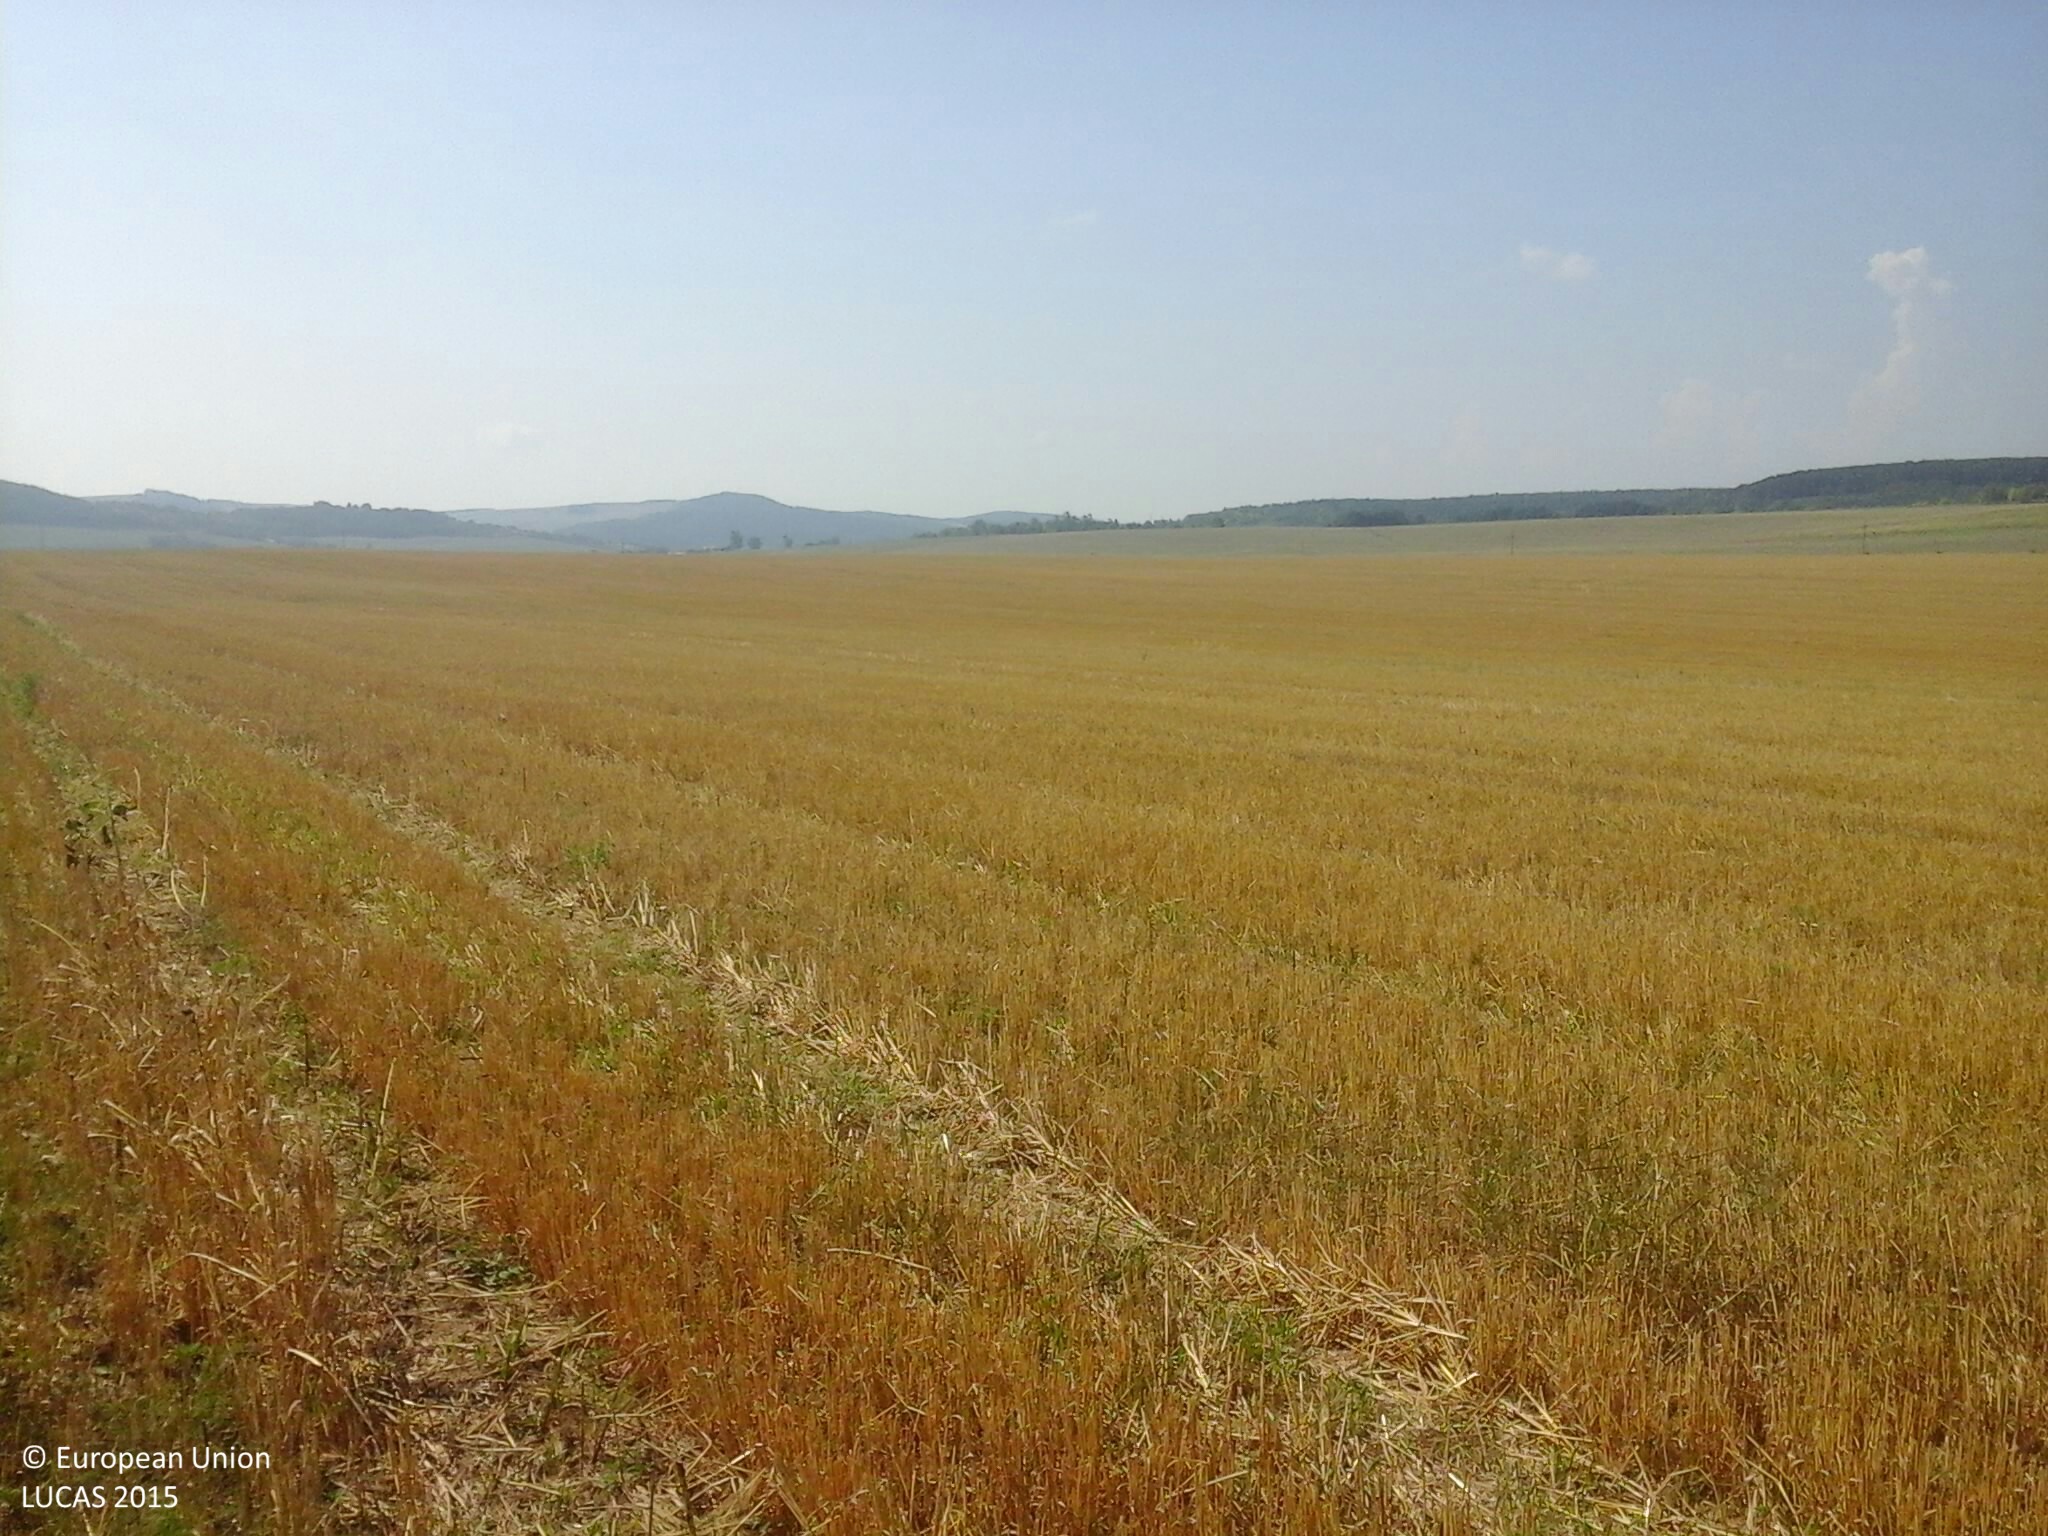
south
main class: Cropland
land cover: Barley
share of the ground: 10 - 25 %
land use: Agriculture (excluding fallow land and kitchen gardens)
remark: Harvested field
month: August
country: HU
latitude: 46.8279
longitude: 18.0184
